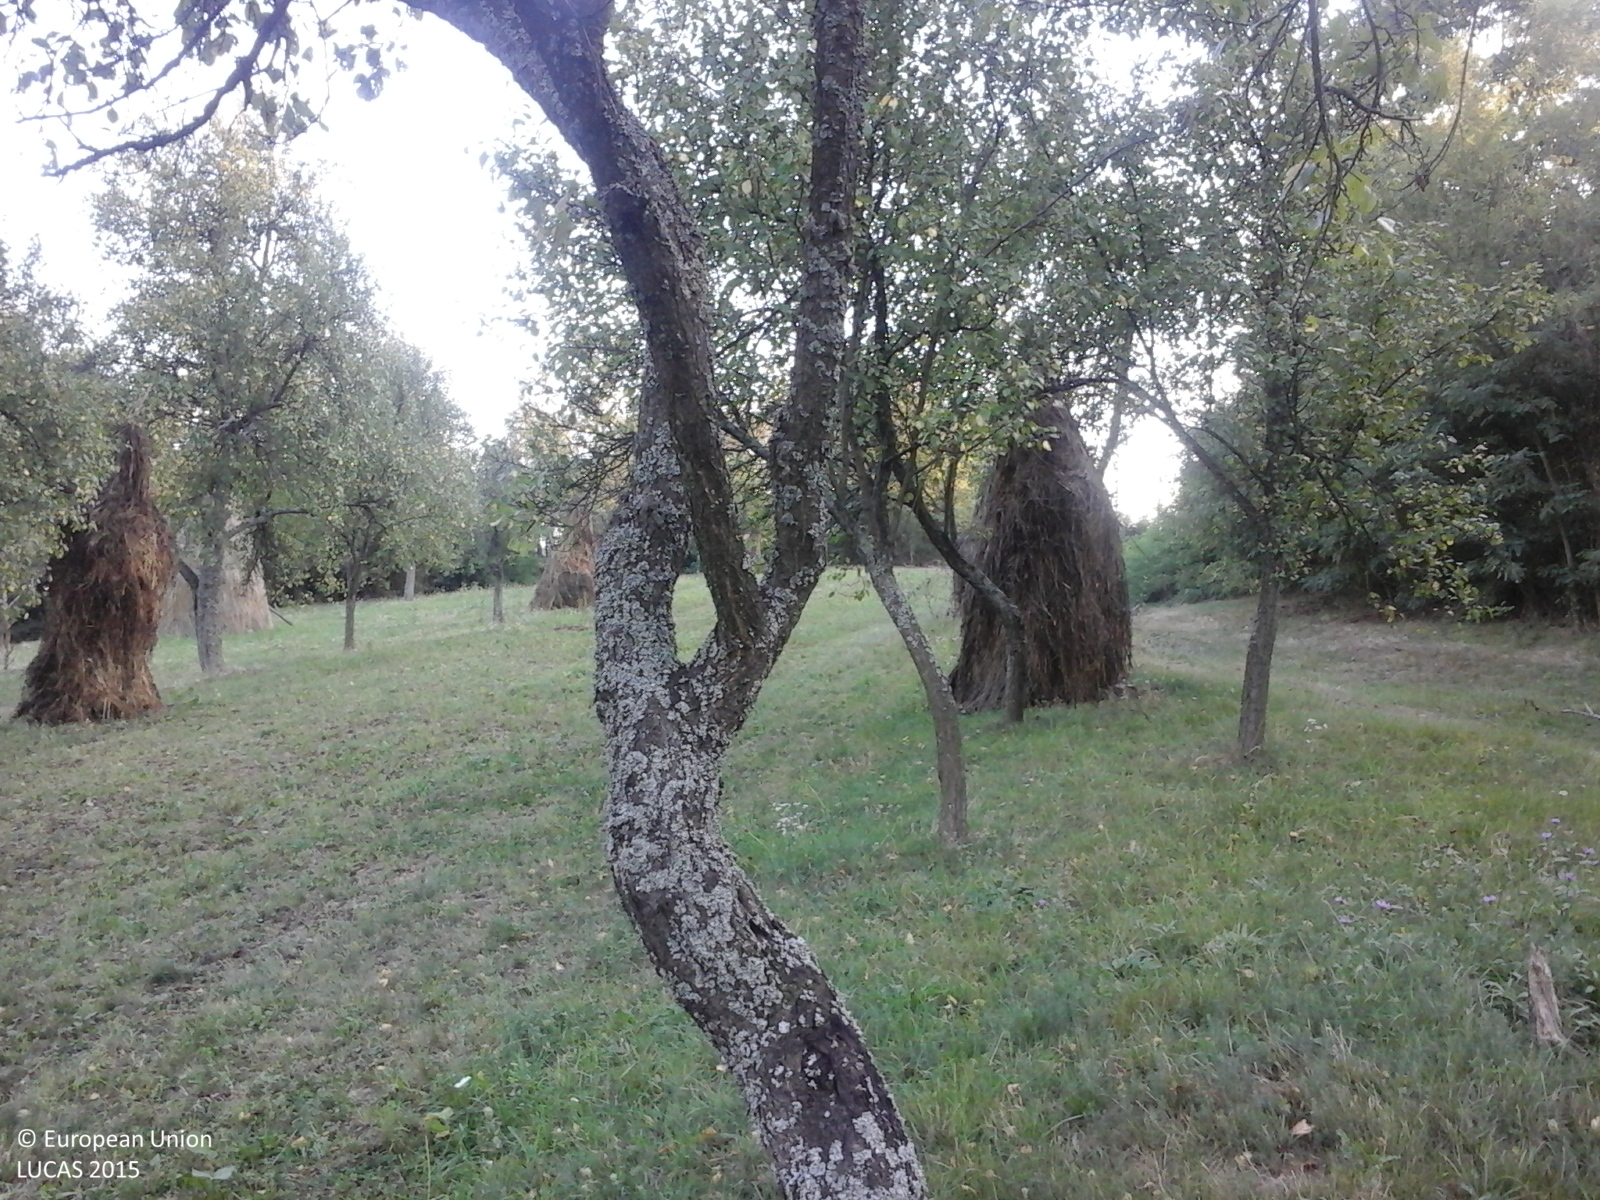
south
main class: Cropland
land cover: Other fruit trees and berries
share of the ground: > 75 %
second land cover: Grassland without tree/shrub cover
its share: > 75 %
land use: Agriculture (excluding fallow land and kitchen gardens)
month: September
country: RO
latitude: 45.1301
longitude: 22.2841
